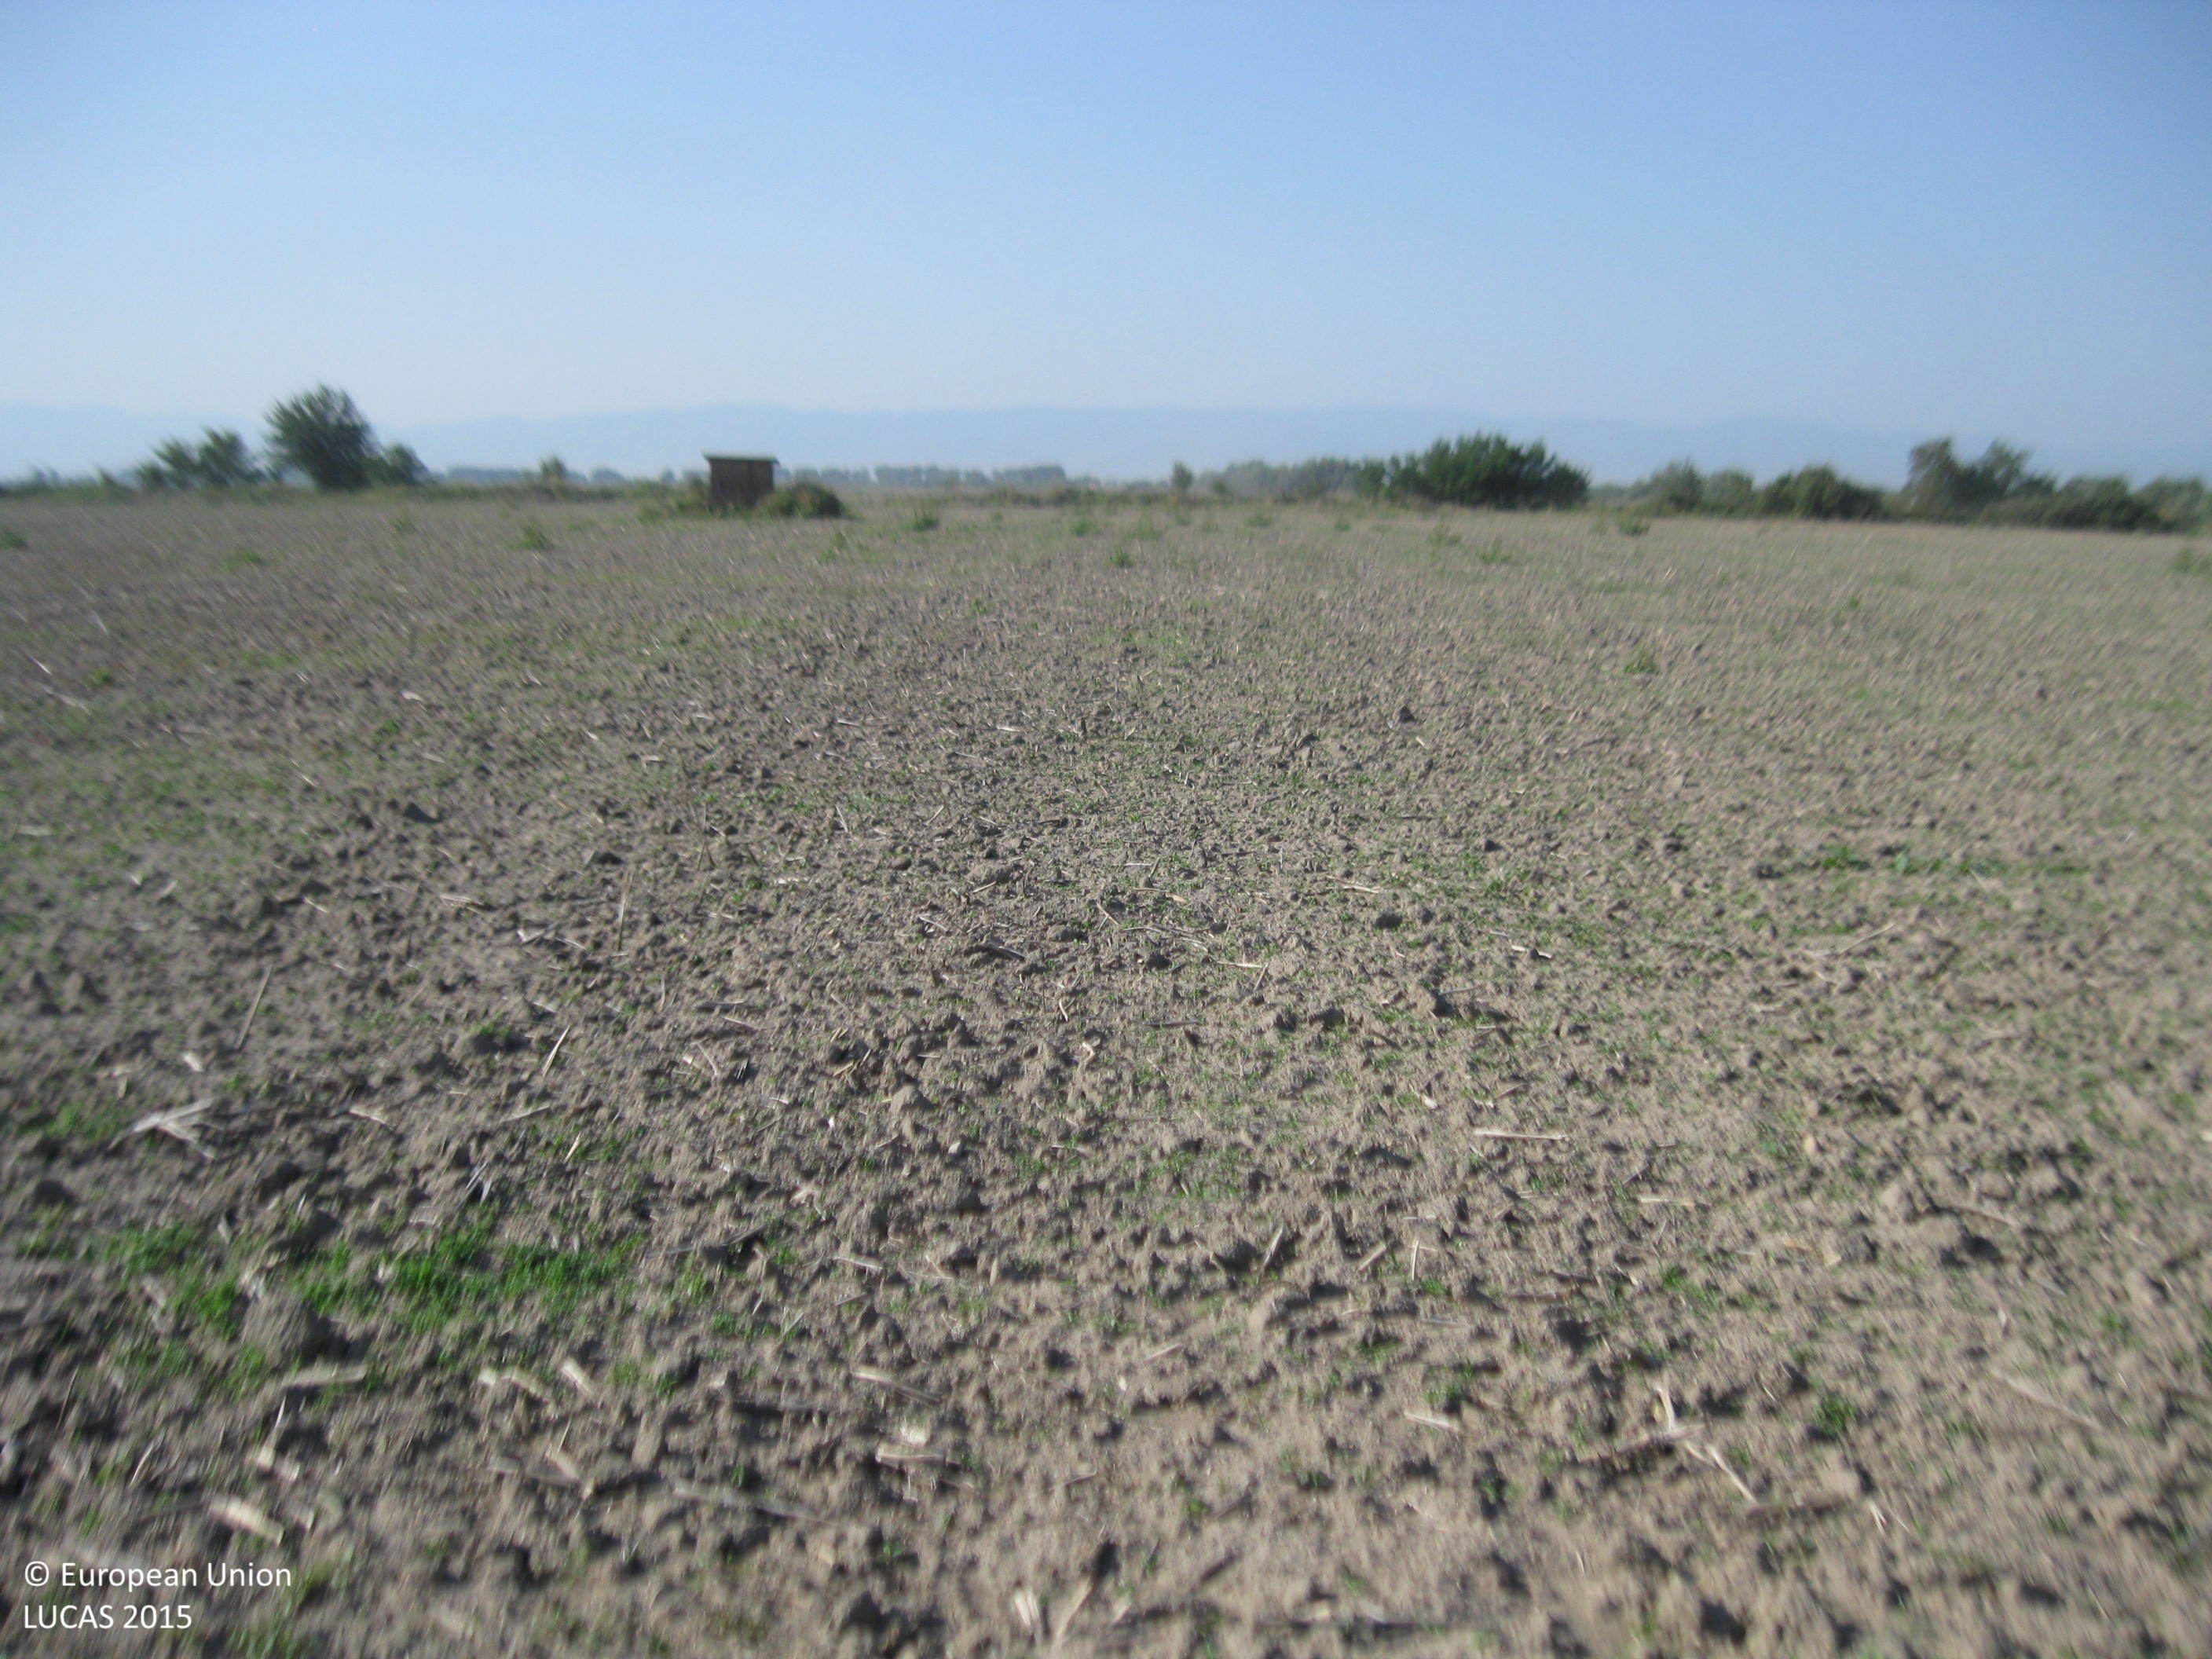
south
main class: Cropland
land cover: Sunflower
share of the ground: < 10 %
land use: Agriculture (excluding fallow land and kitchen gardens)
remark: Harvested field
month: September
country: BG
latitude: 42.2874
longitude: 24.8382
